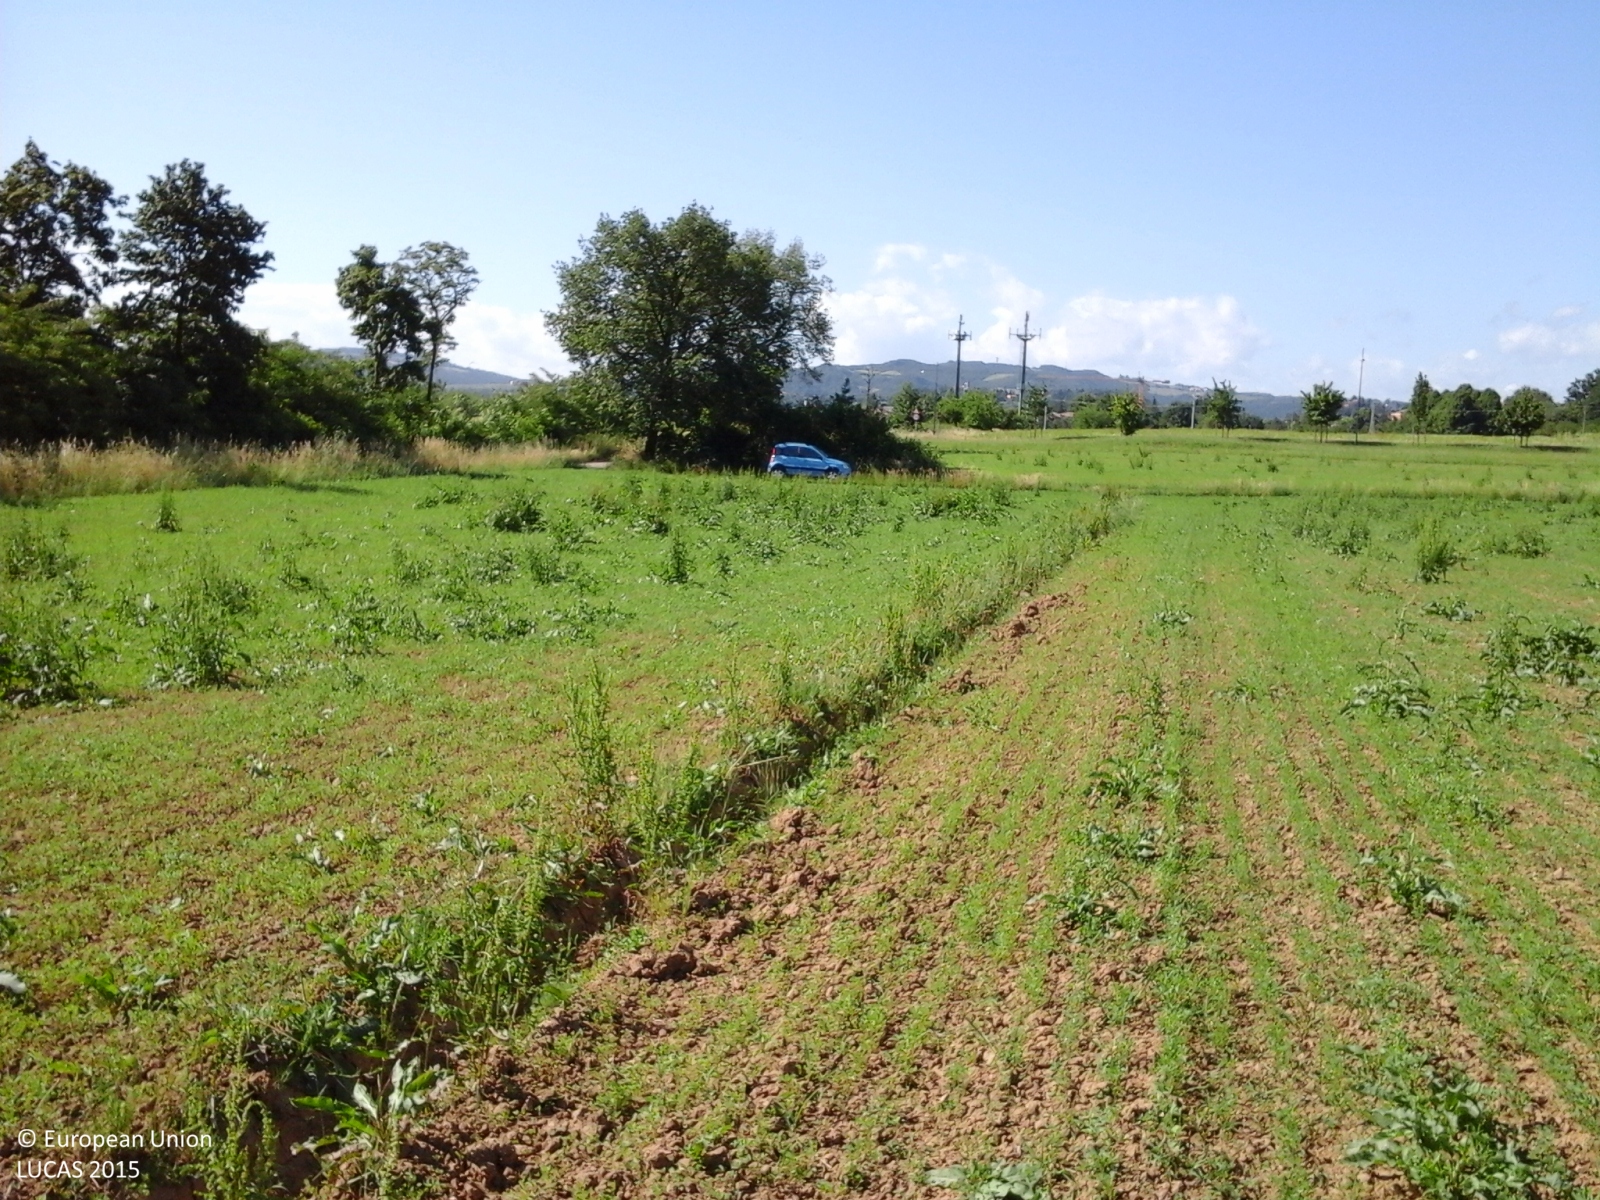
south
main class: Cropland
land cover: Lucerne
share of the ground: 50 - 75 %
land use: Agriculture (excluding fallow land and kitchen gardens)
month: May
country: IT
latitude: 44.6373
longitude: 10.6164
